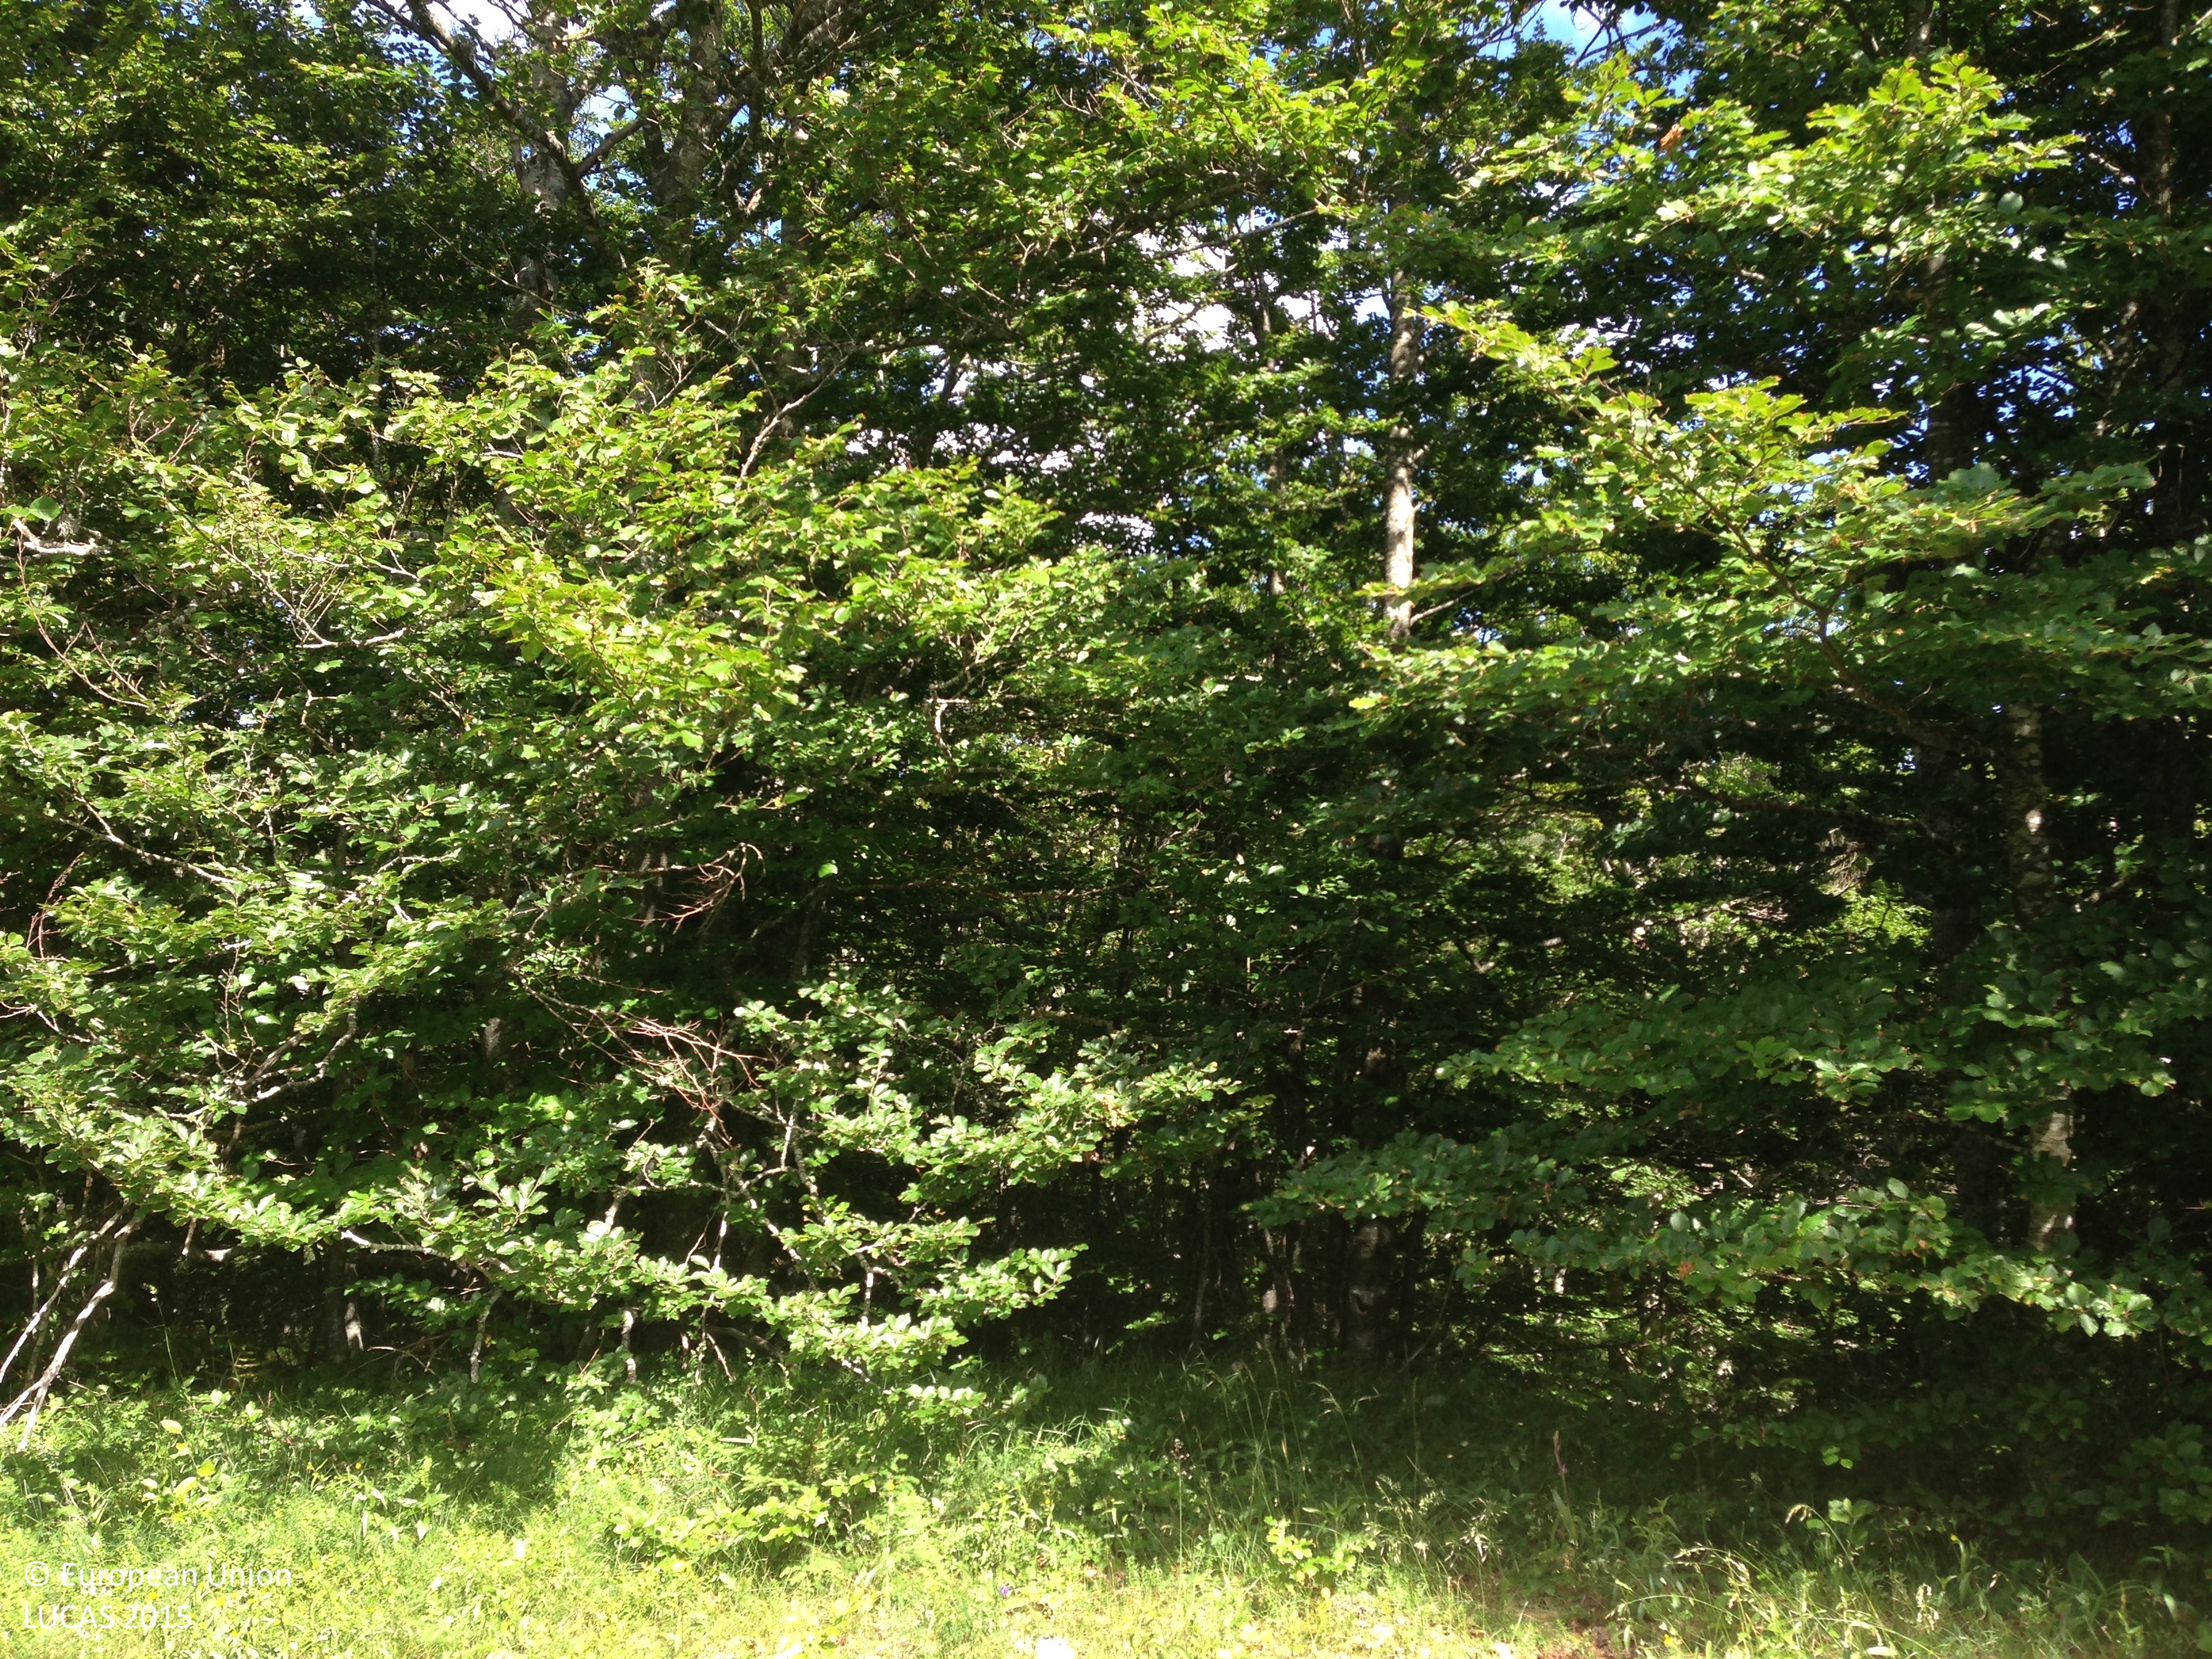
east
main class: Woodland
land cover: Pine dominated mixed woodland
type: alpine coniferous forest
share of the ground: > 75 %
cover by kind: coniferous forest trees 55 %, broadleaved forest trees 20 %, herbaceous plants 20 %, shrubs 5 %
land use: Forestry
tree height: > 5 m
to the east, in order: Pine dominated mixed woodland
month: June
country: HR
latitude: 44.6744
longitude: 15.8348
